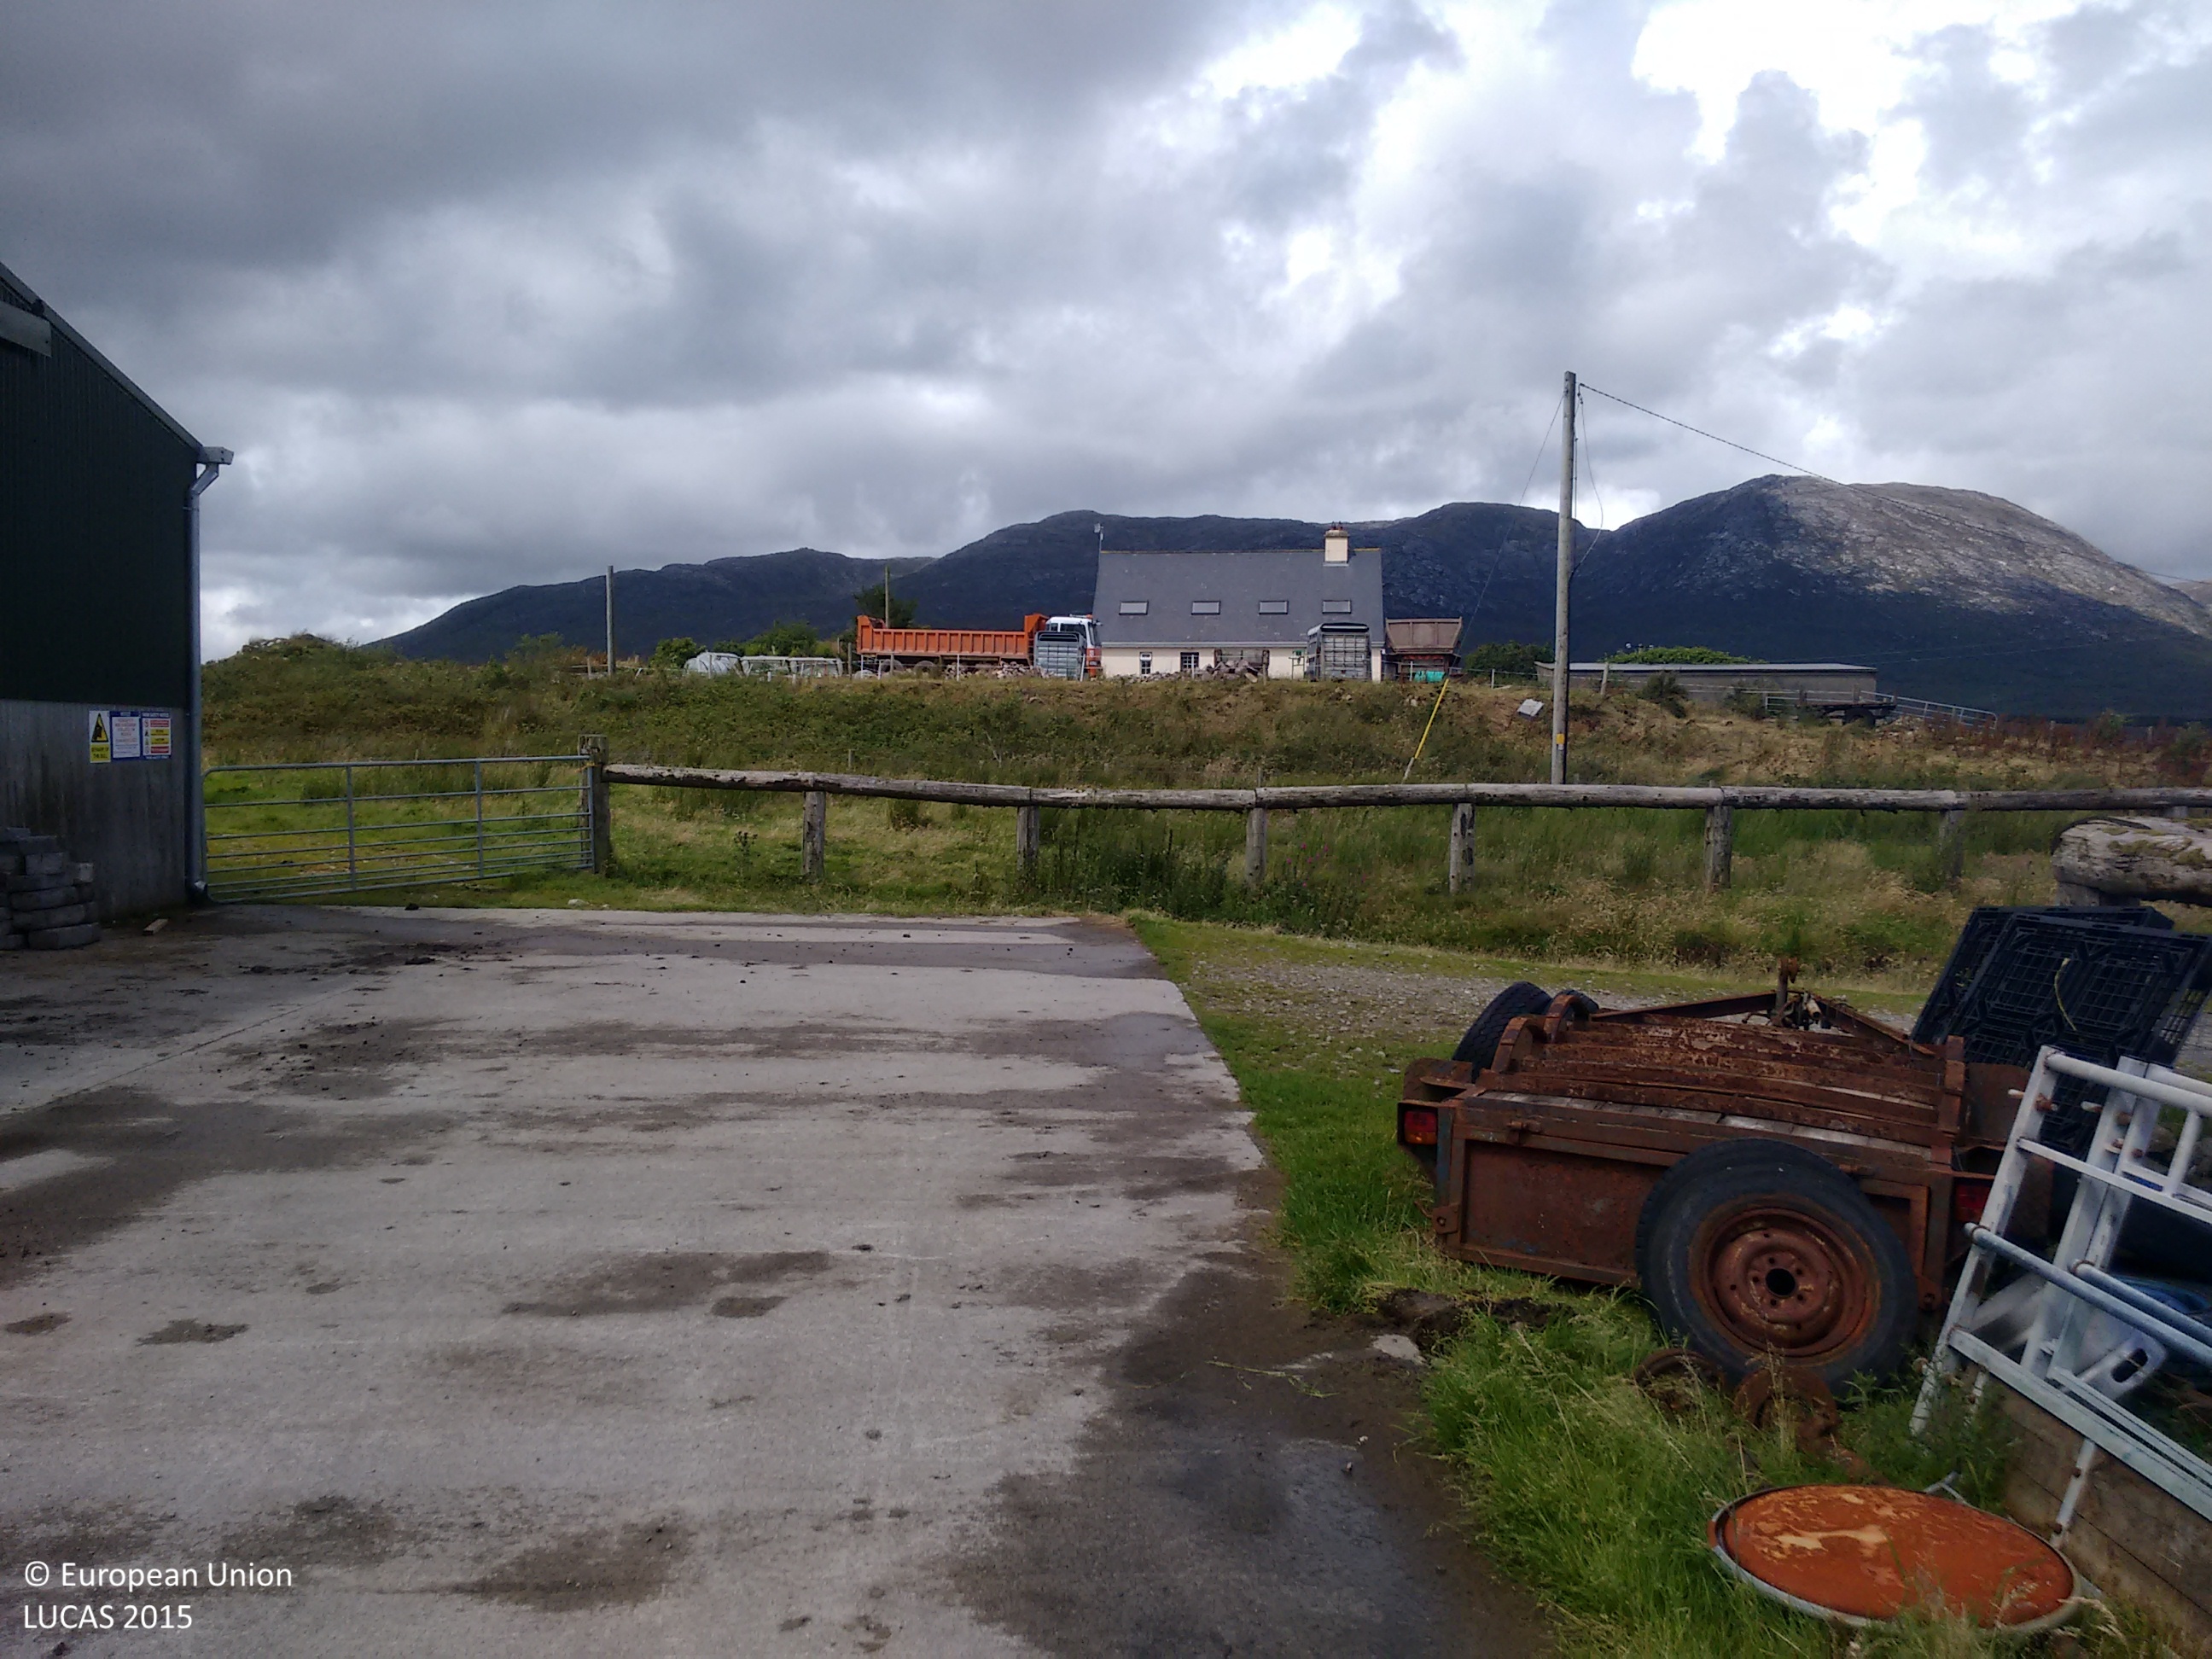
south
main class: Grassland
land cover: Grassland without tree/shrub cover
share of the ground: > 75 %
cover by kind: herbaceous plants 80 %, consolidated bare surface 20 %
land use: Agriculture (excluding fallow land and kitchen gardens)
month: July
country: IE
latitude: 53.4428
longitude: -9.6134
